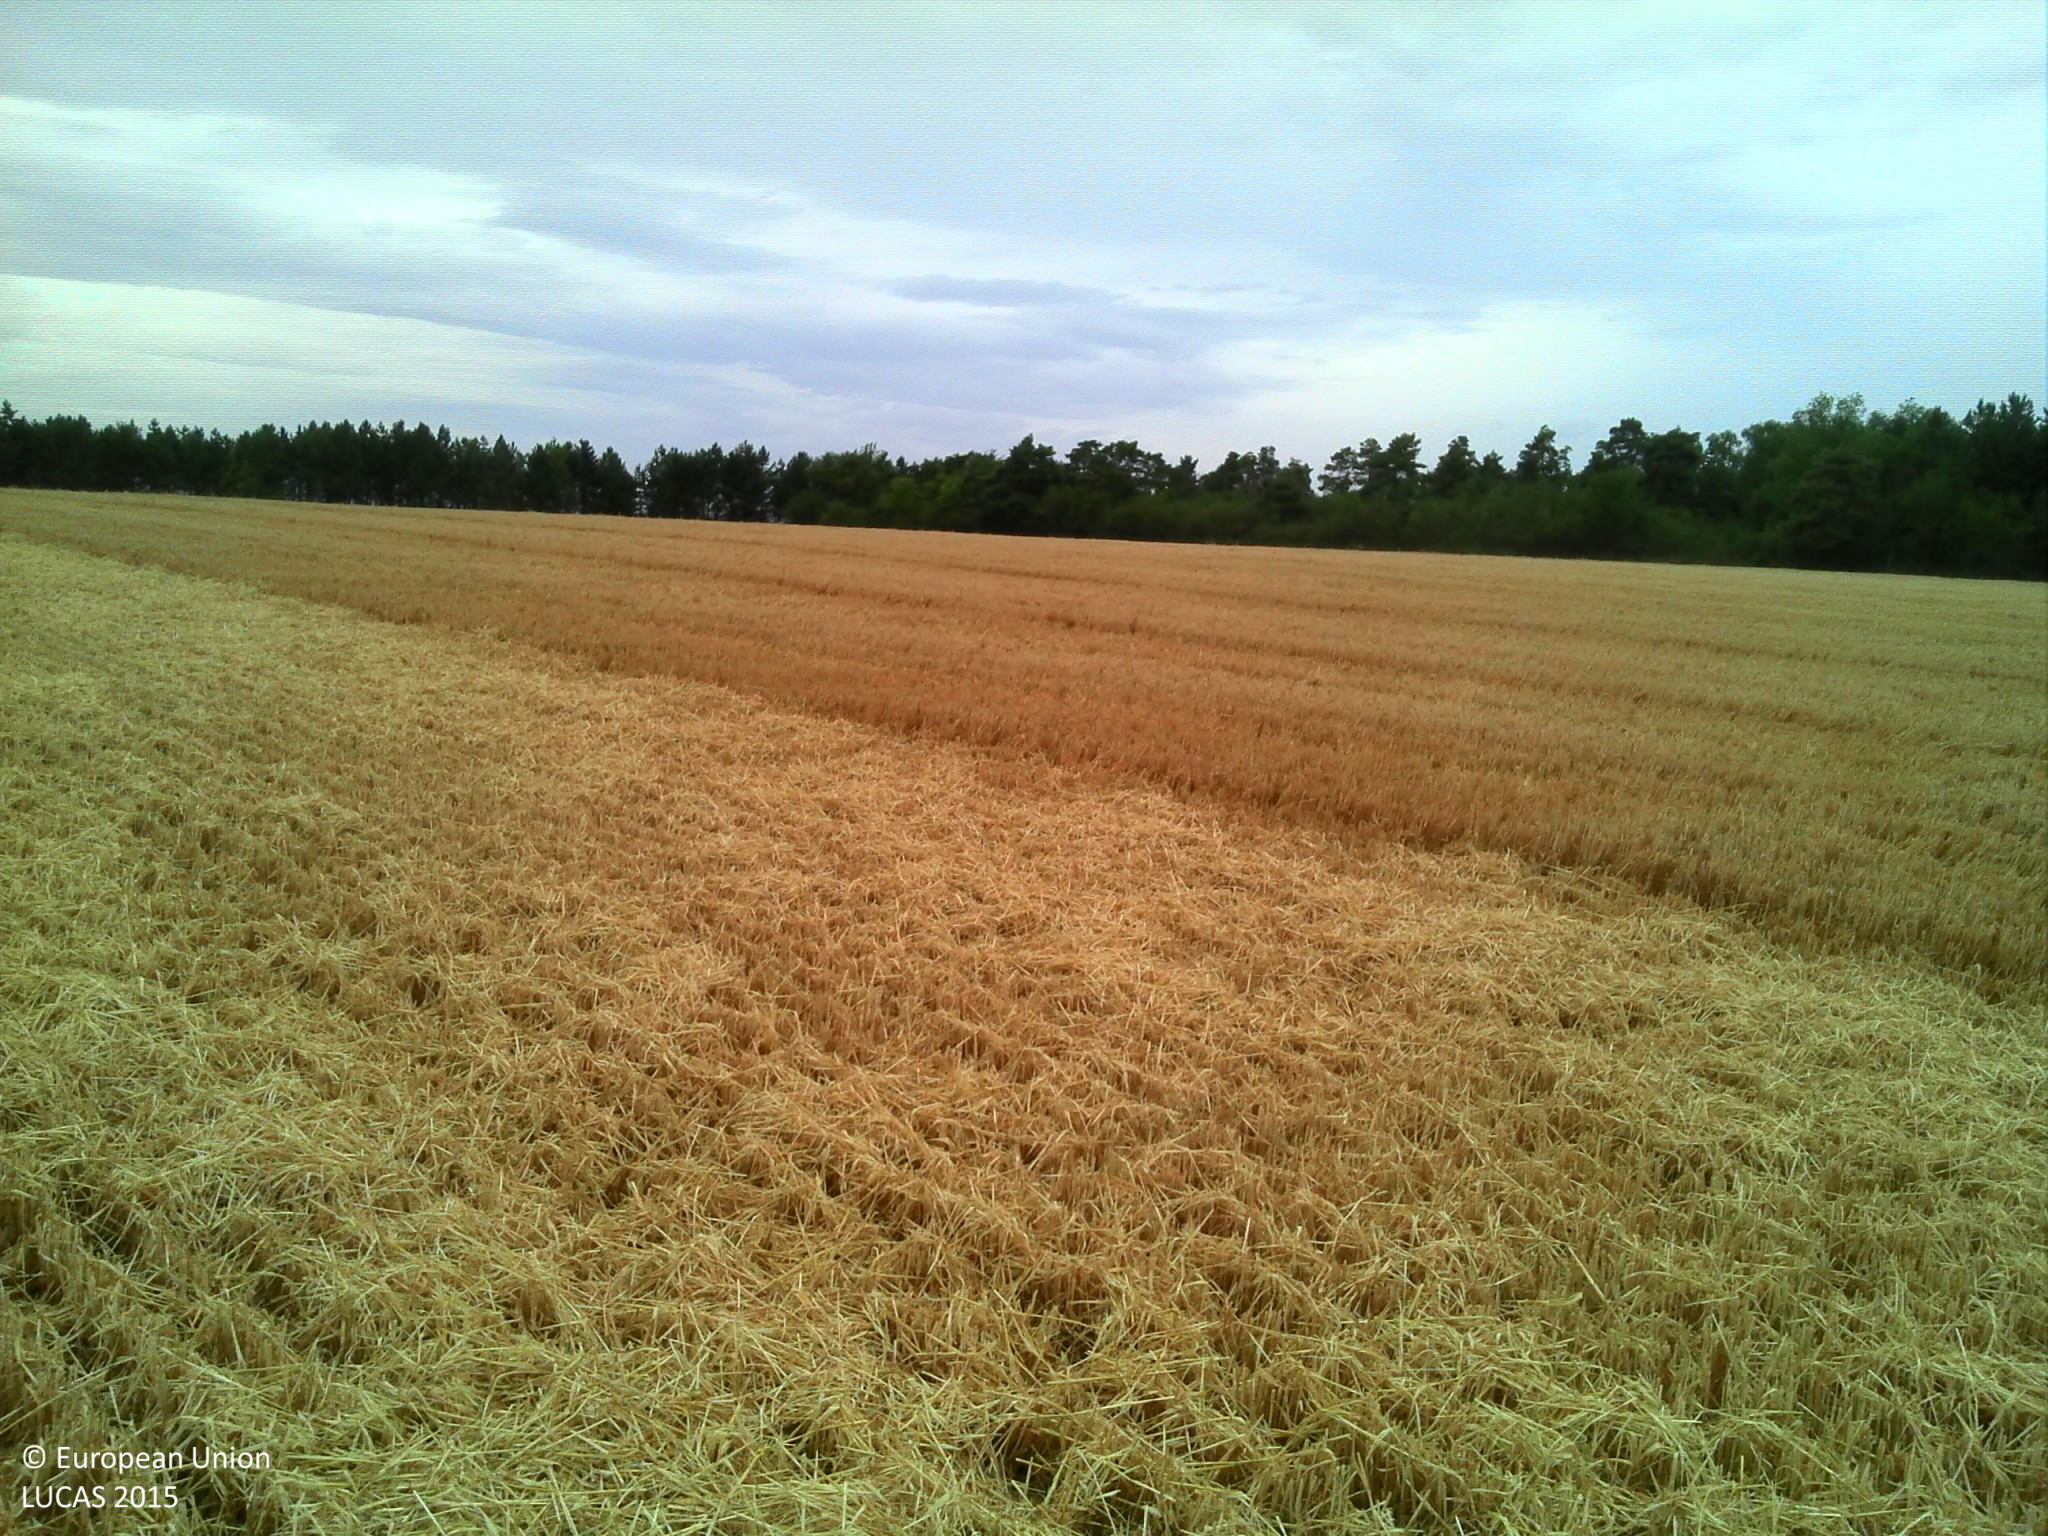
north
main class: Cropland
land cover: Rye
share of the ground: > 75 %
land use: Agriculture (excluding fallow land and kitchen gardens)
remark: Harvested field
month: July
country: FR
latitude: 49.2246
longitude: 4.1874
